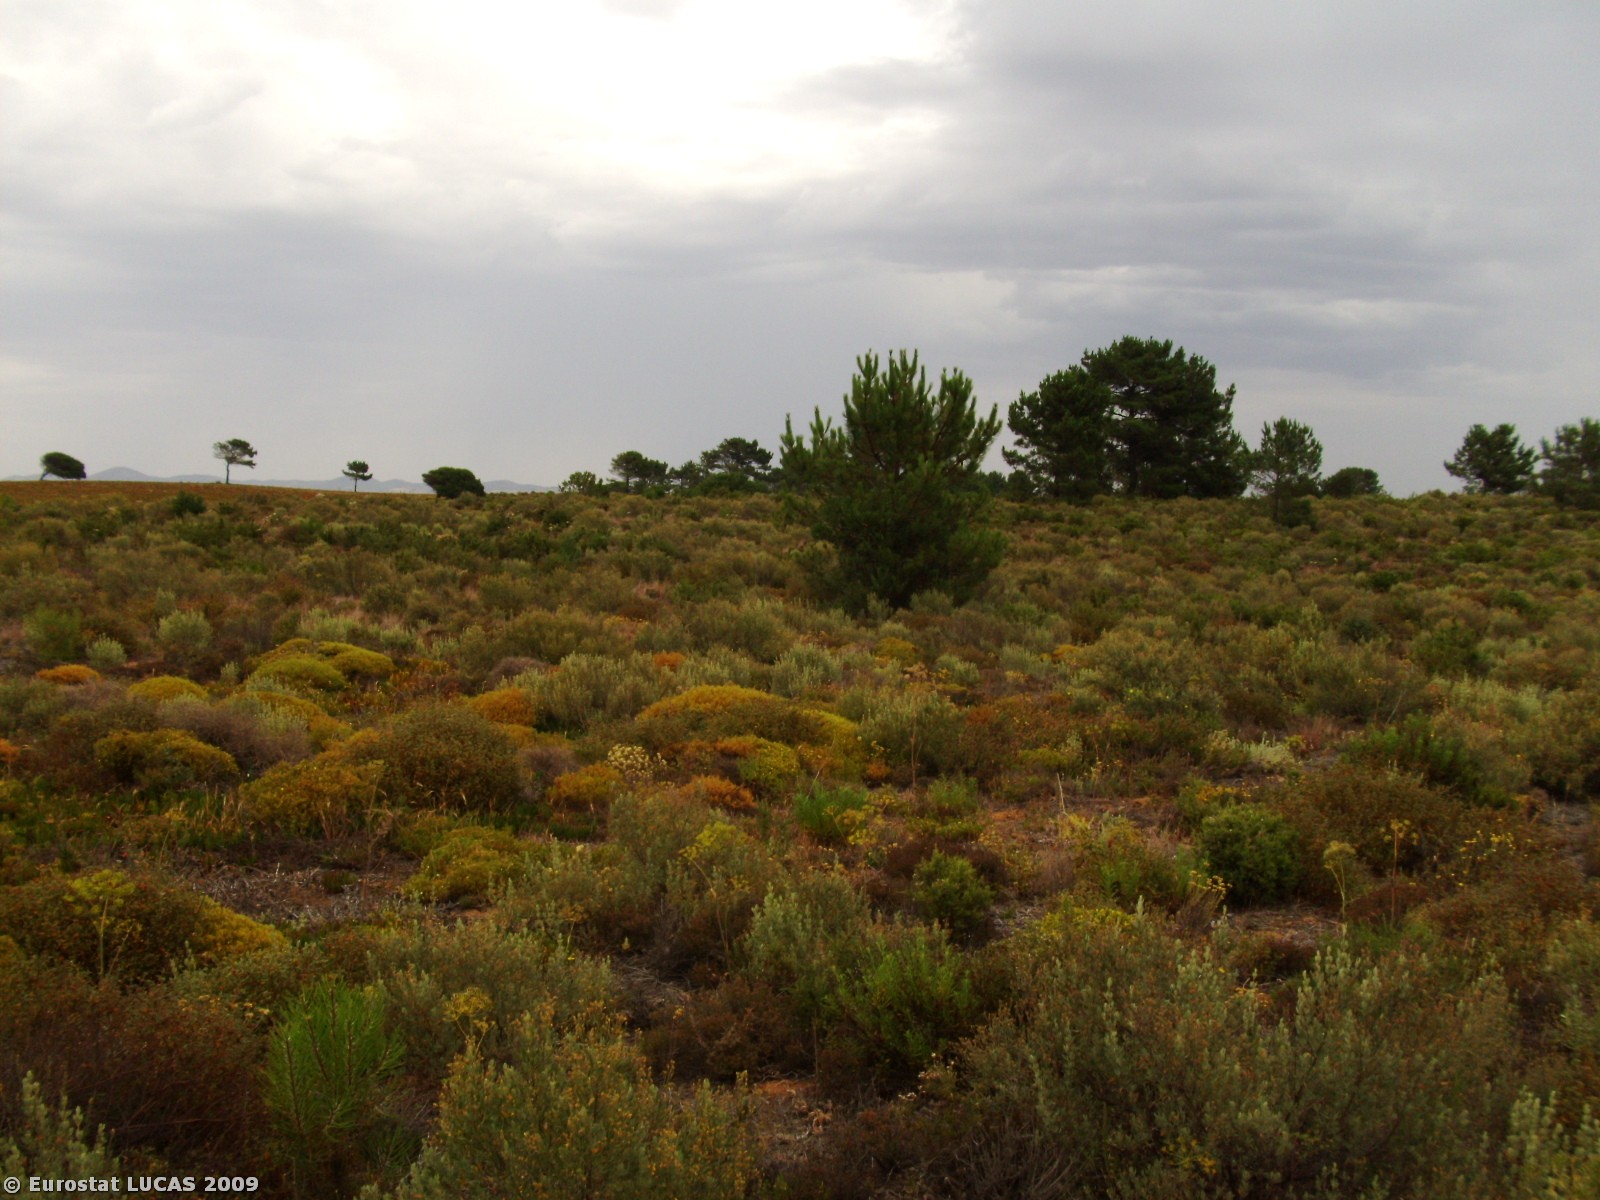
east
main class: Shrubland
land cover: Shrubland without tree cover
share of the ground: > 75 %
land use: Nature reserves
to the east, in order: Shrubland without tree cover; Shrubland with sparse tree cover; Shrubland without tree cover
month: June
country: PT
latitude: 37.6351
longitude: -8.7974
